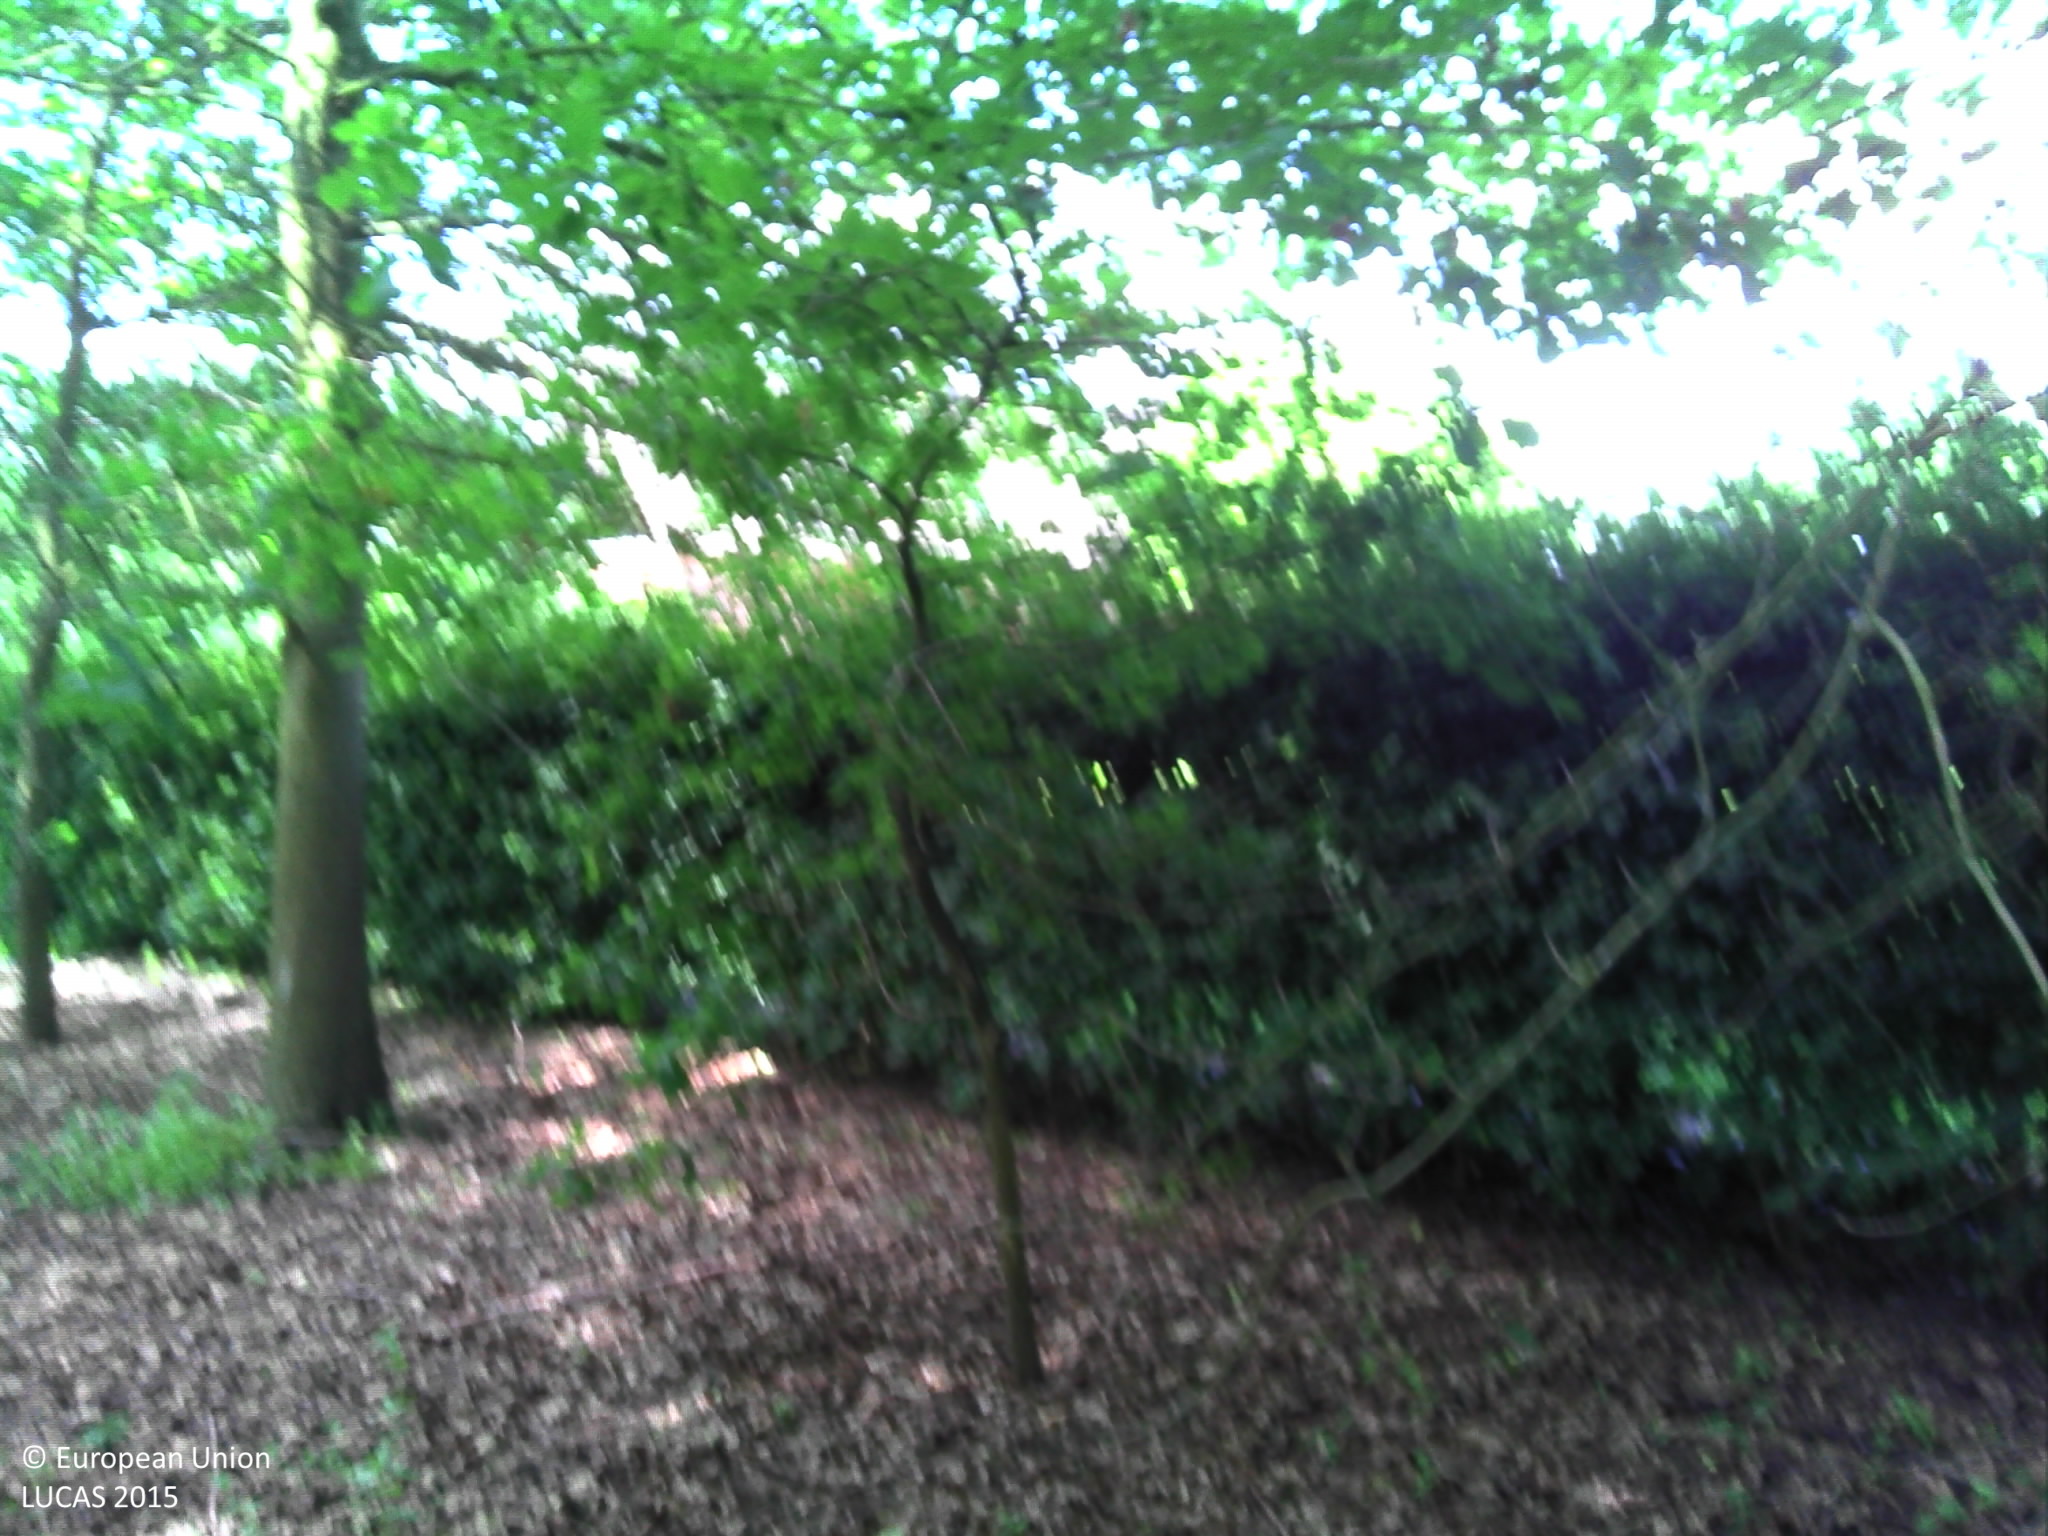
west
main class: Woodland
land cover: Broadleaved woodland
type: mesophytic deciduous forest
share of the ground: > 75 %
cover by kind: broadleaved forest trees 100 %
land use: Residential
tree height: > 5 m
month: June
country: BE
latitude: 50.8935
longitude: 3.6948
